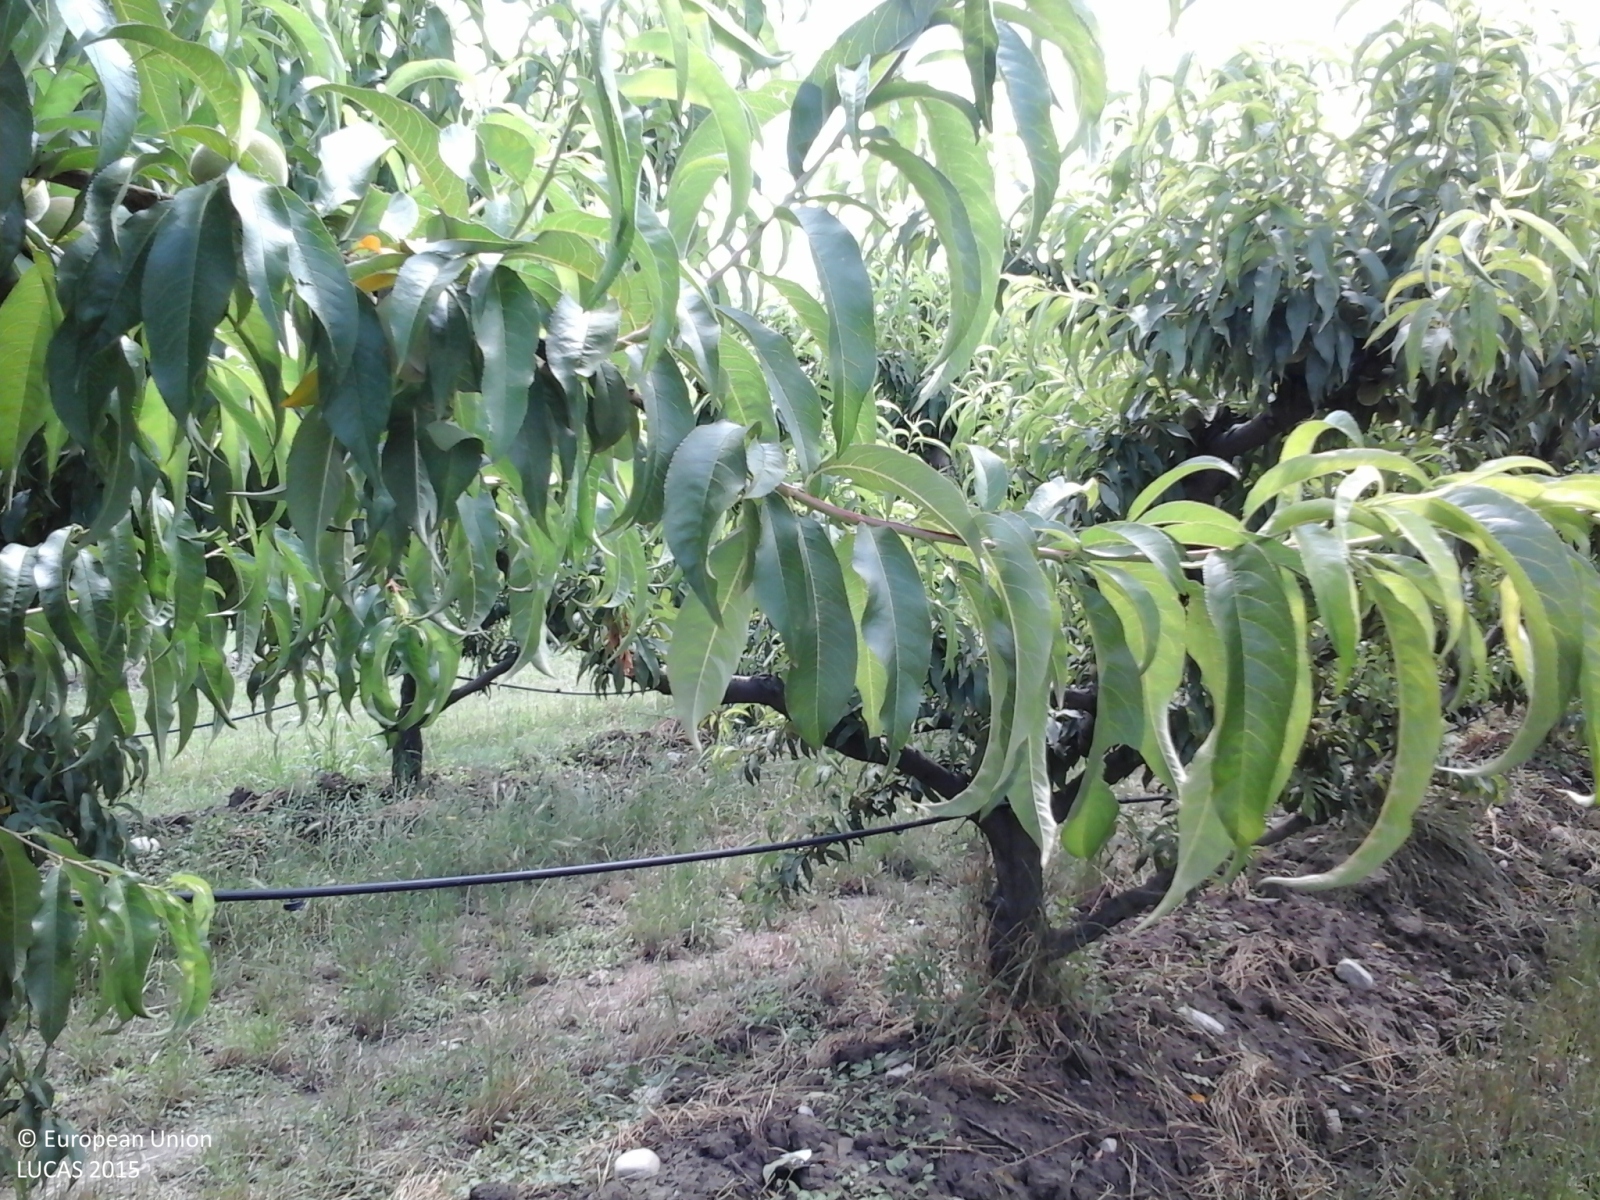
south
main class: Cropland
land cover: Other fruit trees and berries
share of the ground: 50 - 75 %
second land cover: Grassland without tree/shrub cover
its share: > 75 %
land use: Agriculture (excluding fallow land and kitchen gardens)
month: June
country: IT
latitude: 44.2839
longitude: 11.6128
